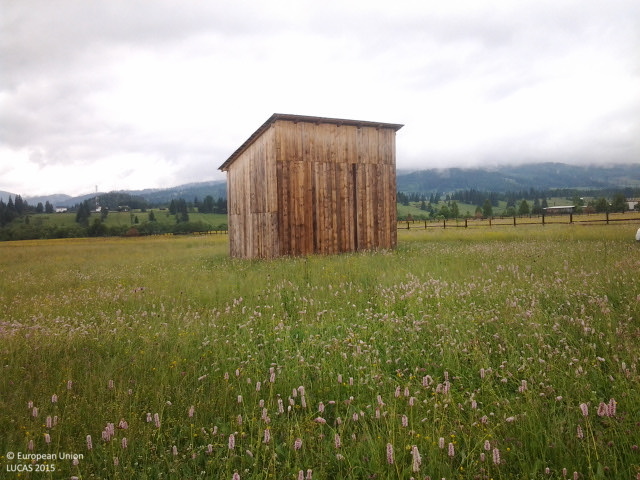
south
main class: Grassland
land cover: Grassland without tree/shrub cover
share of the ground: > 75 %
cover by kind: herbaceous plants 100 %
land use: Agriculture (excluding fallow land and kitchen gardens)
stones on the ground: < 10 %
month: June
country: RO
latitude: 47.2507
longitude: 25.3452
